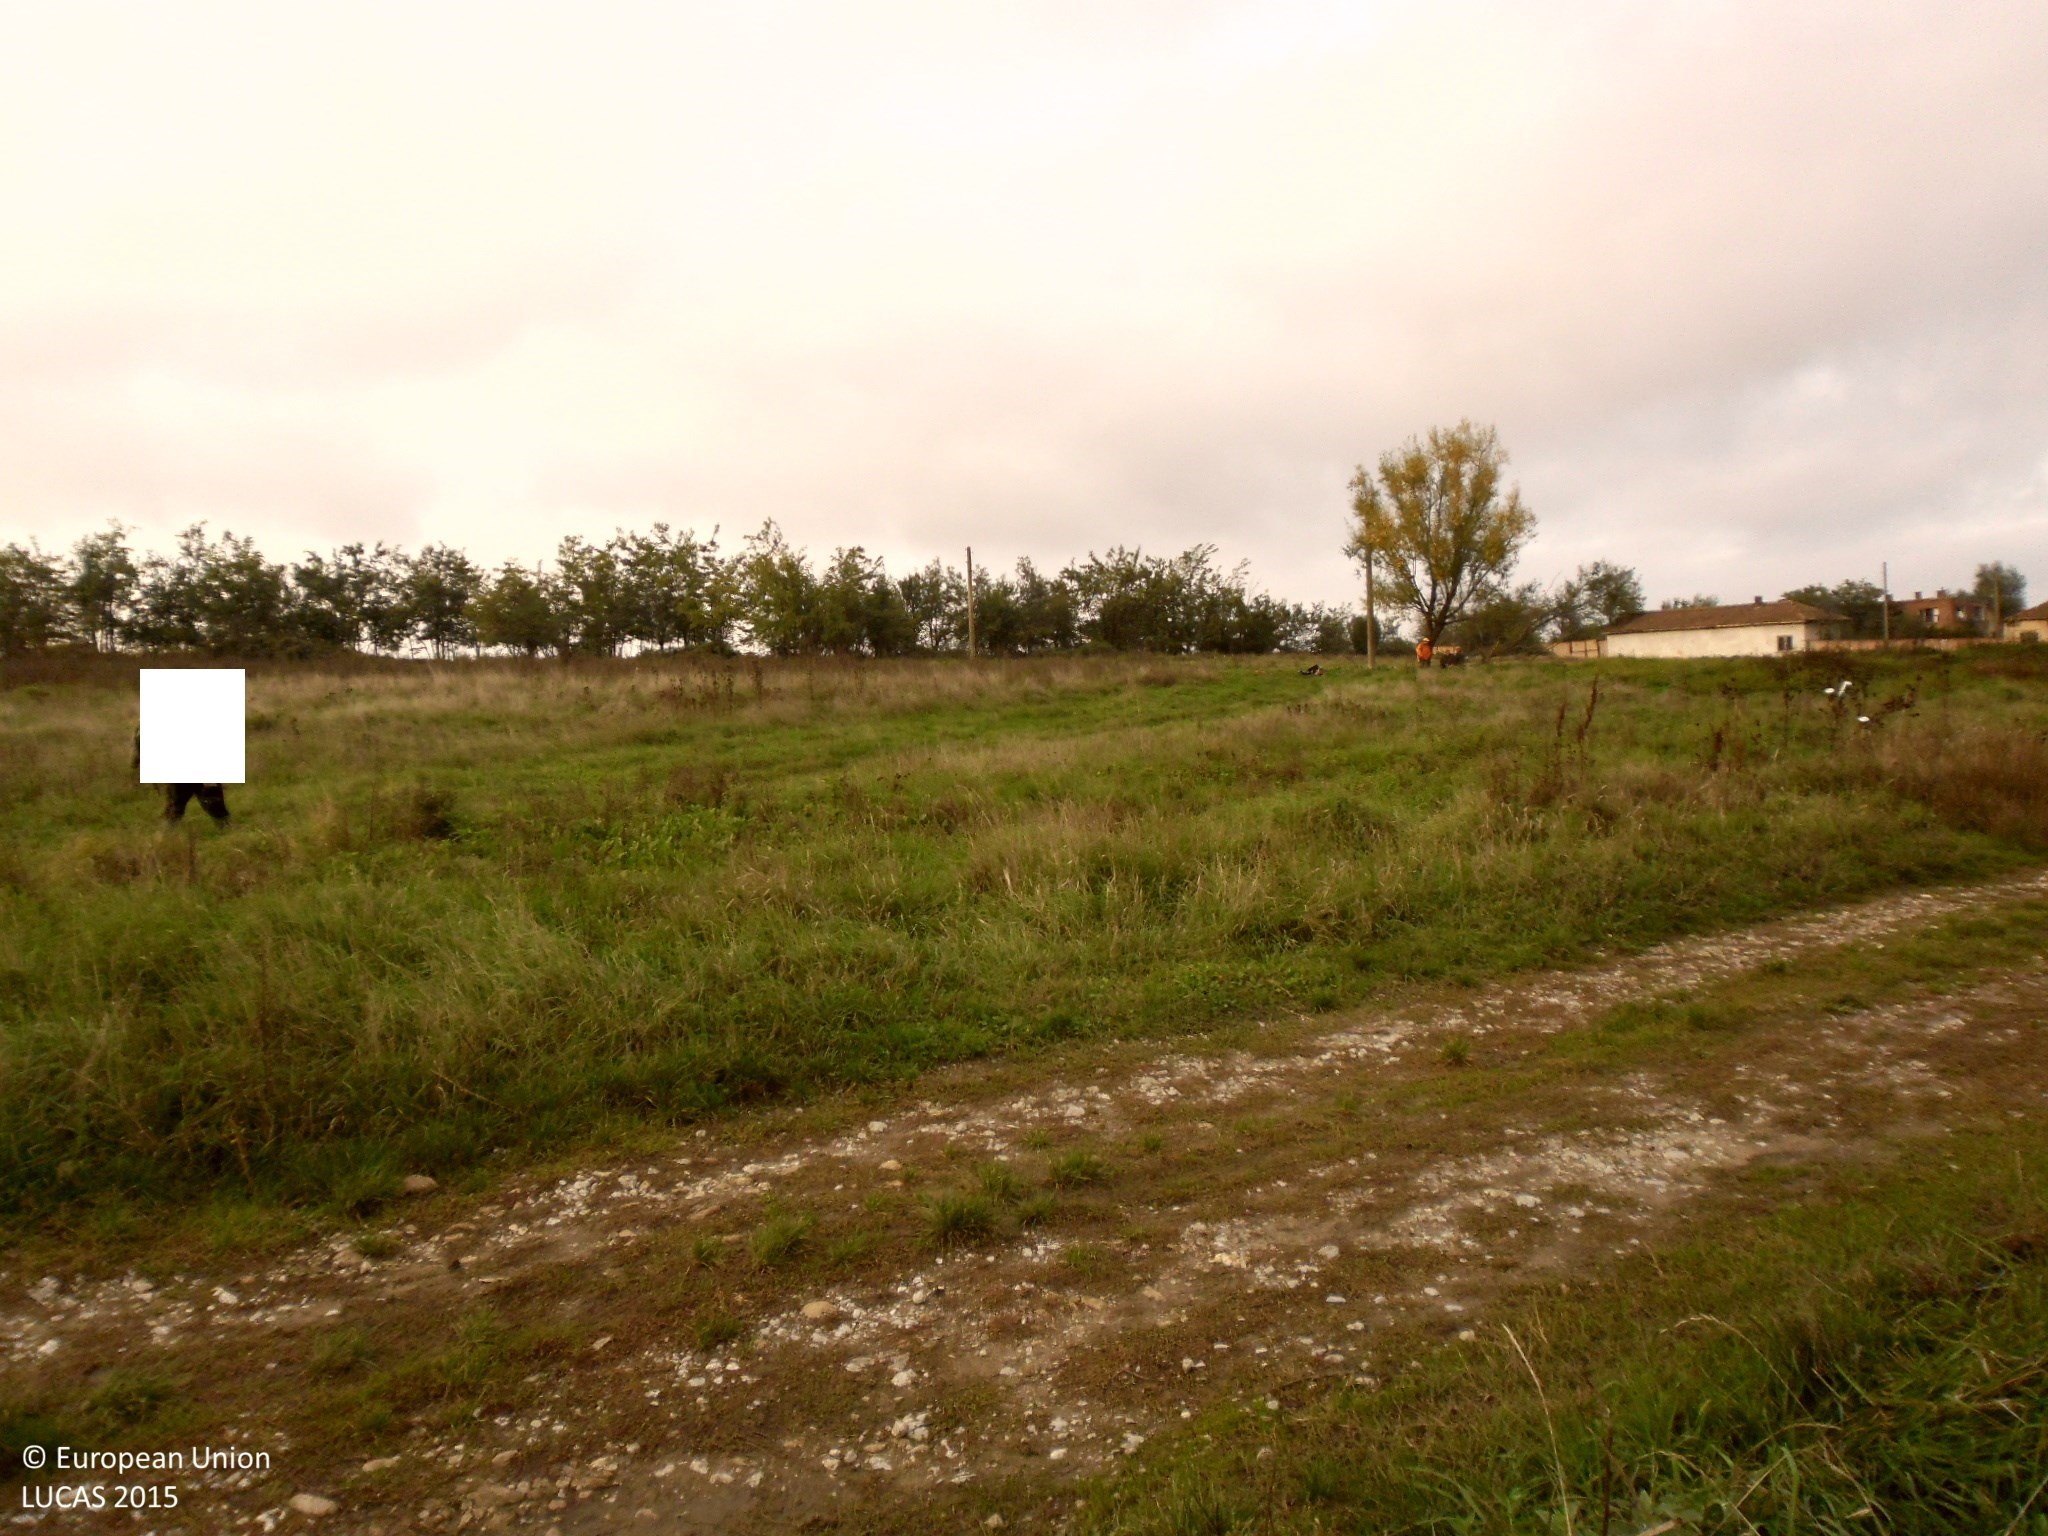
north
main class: Grassland
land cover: Grassland without tree/shrub cover
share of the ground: > 75 %
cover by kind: herbaceous plants 100 %
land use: Agriculture (excluding fallow land and kitchen gardens)
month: October
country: BG
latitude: 43.8308
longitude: 22.4809
